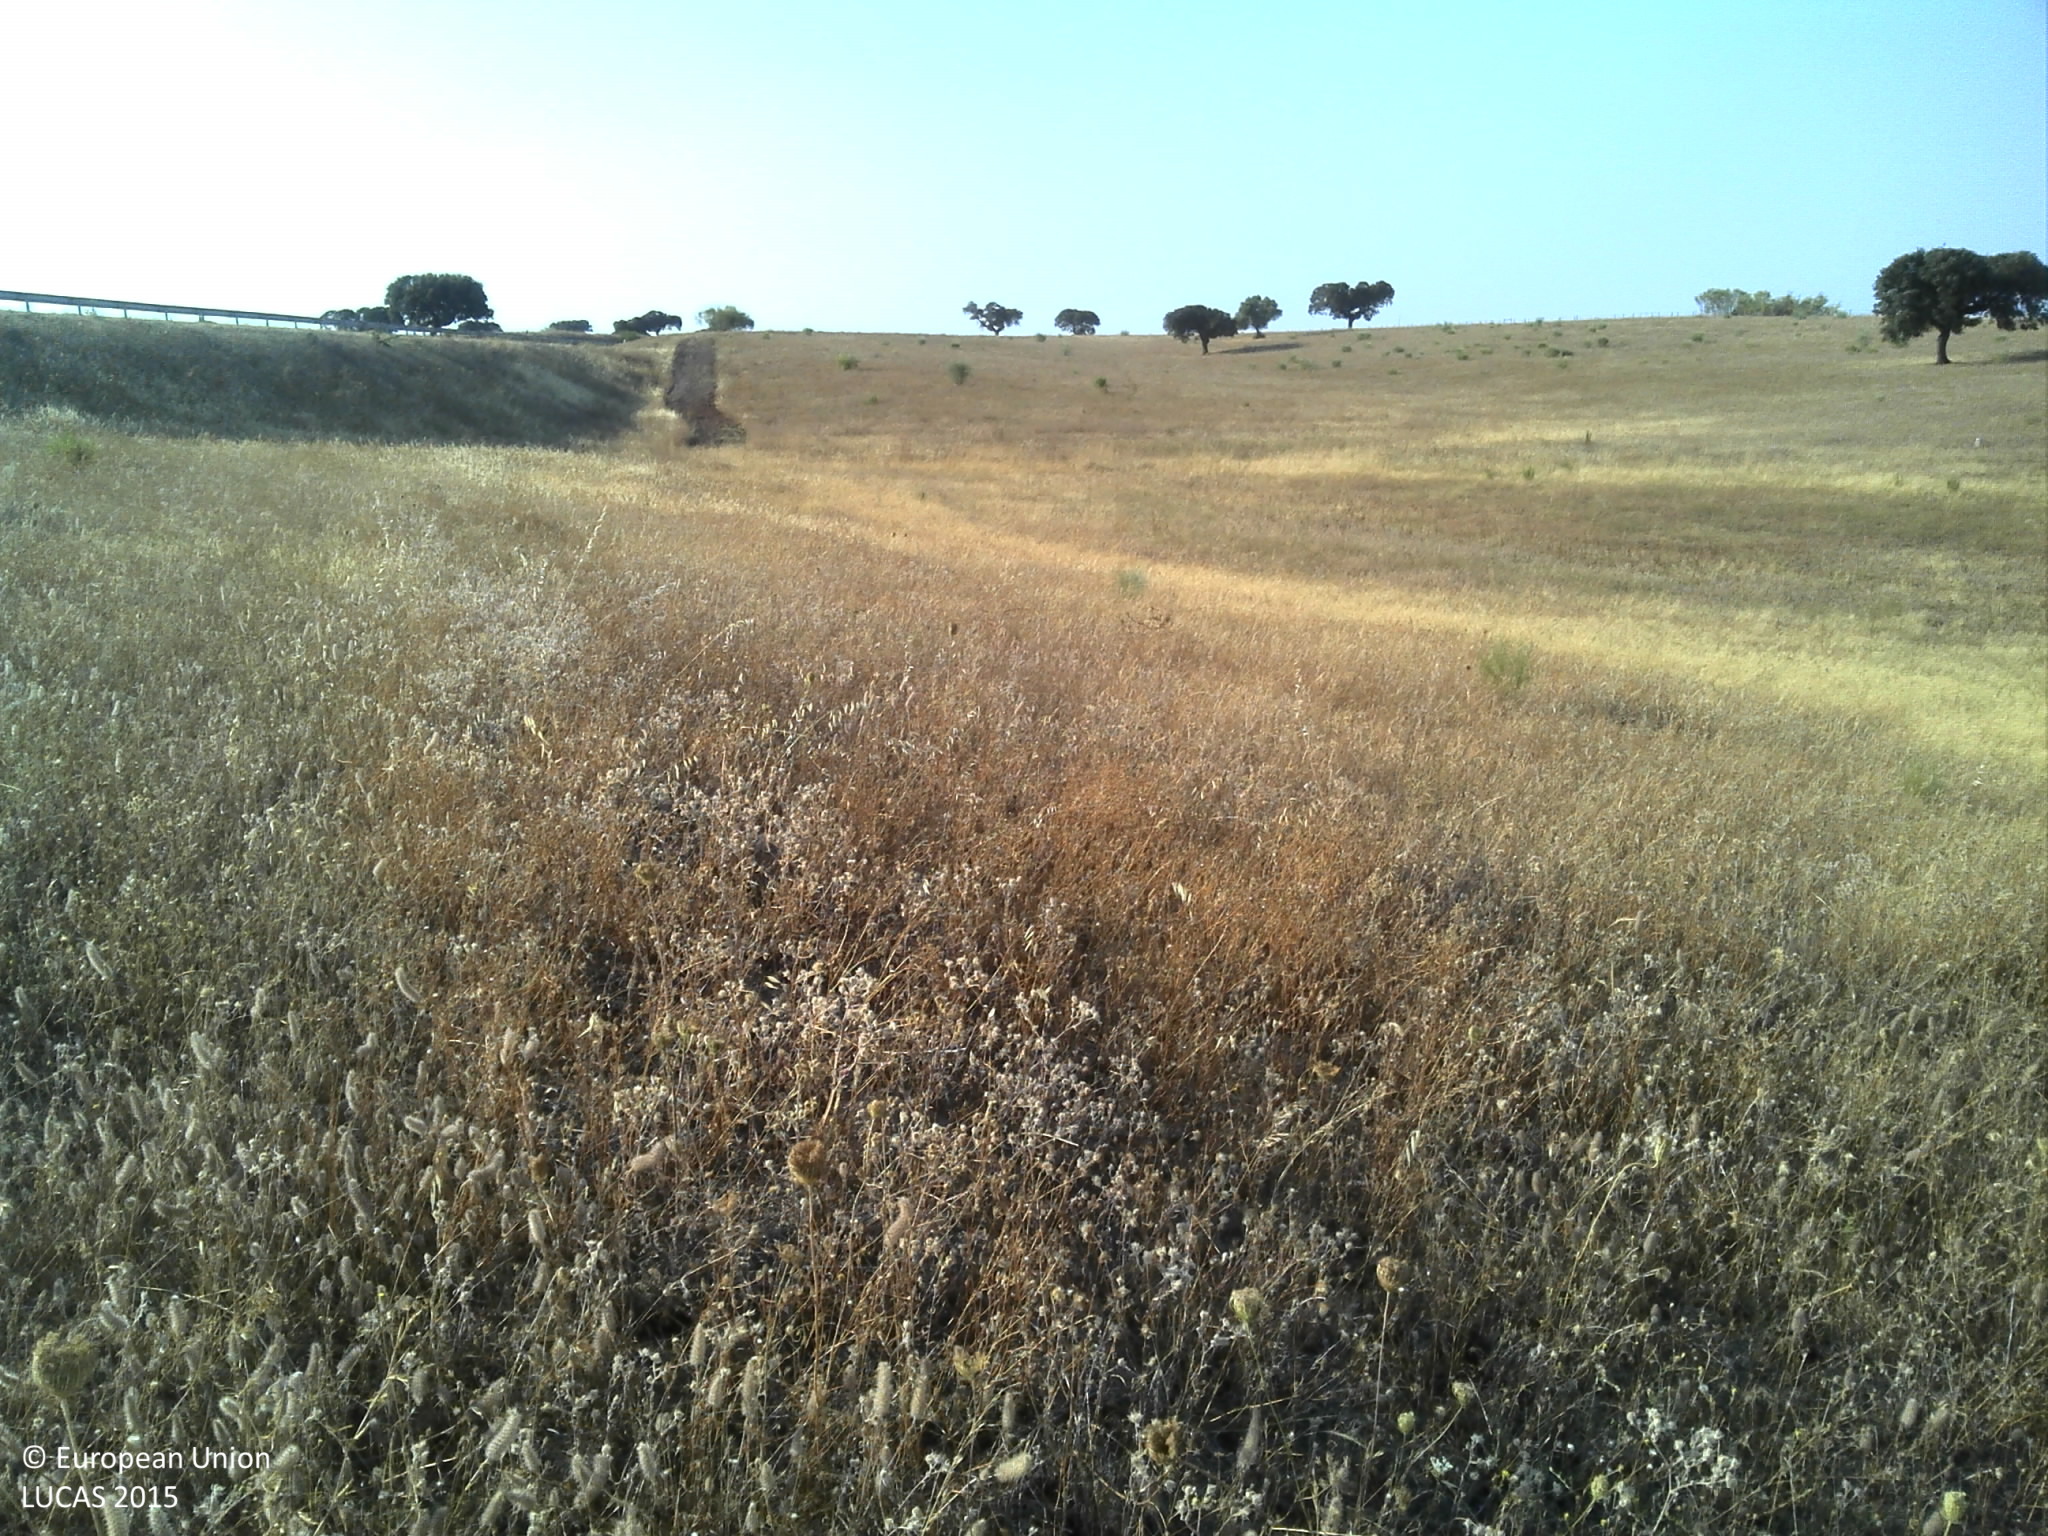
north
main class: Grassland
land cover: Grassland without tree/shrub cover
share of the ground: > 75 %
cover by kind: herbaceous plants 100 %
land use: Agriculture (excluding fallow land and kitchen gardens)
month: June
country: PT
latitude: 38.3244
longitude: -7.3281
